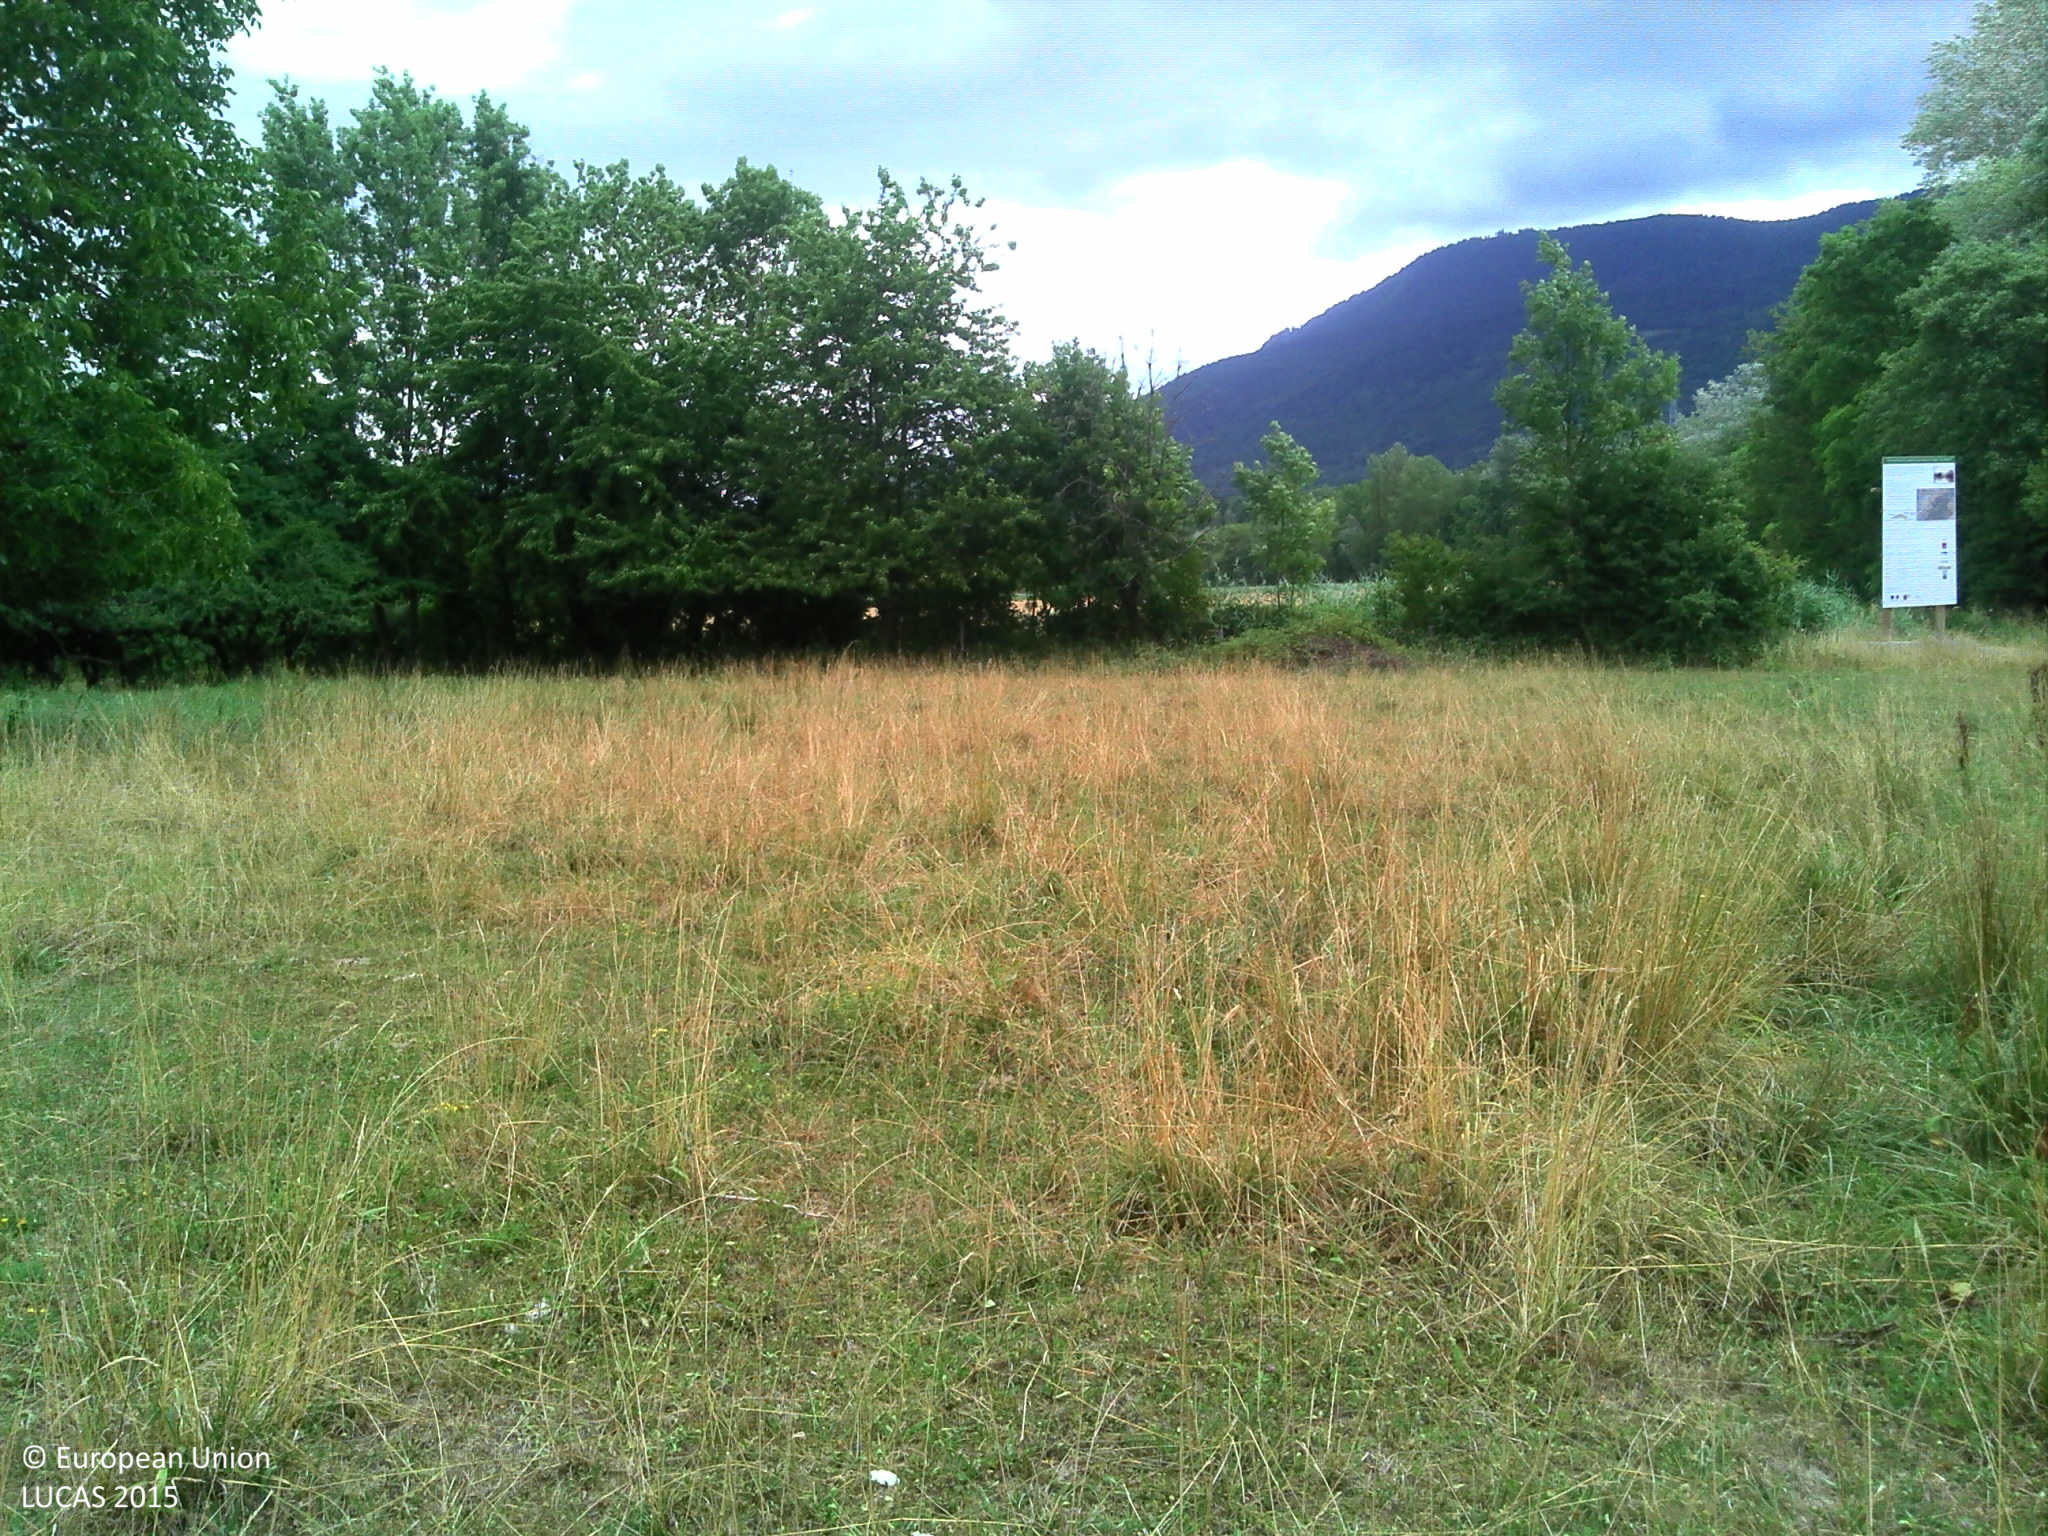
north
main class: Grassland
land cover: Grassland with sparse tree/shrub cover
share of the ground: > 75 %
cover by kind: herbaceous plants 95 %, broadleaved forest trees 5 %
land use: Agriculture (excluding fallow land and kitchen gardens)
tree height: > 5 m
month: July
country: FR
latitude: 46.2145
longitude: 6.2832
